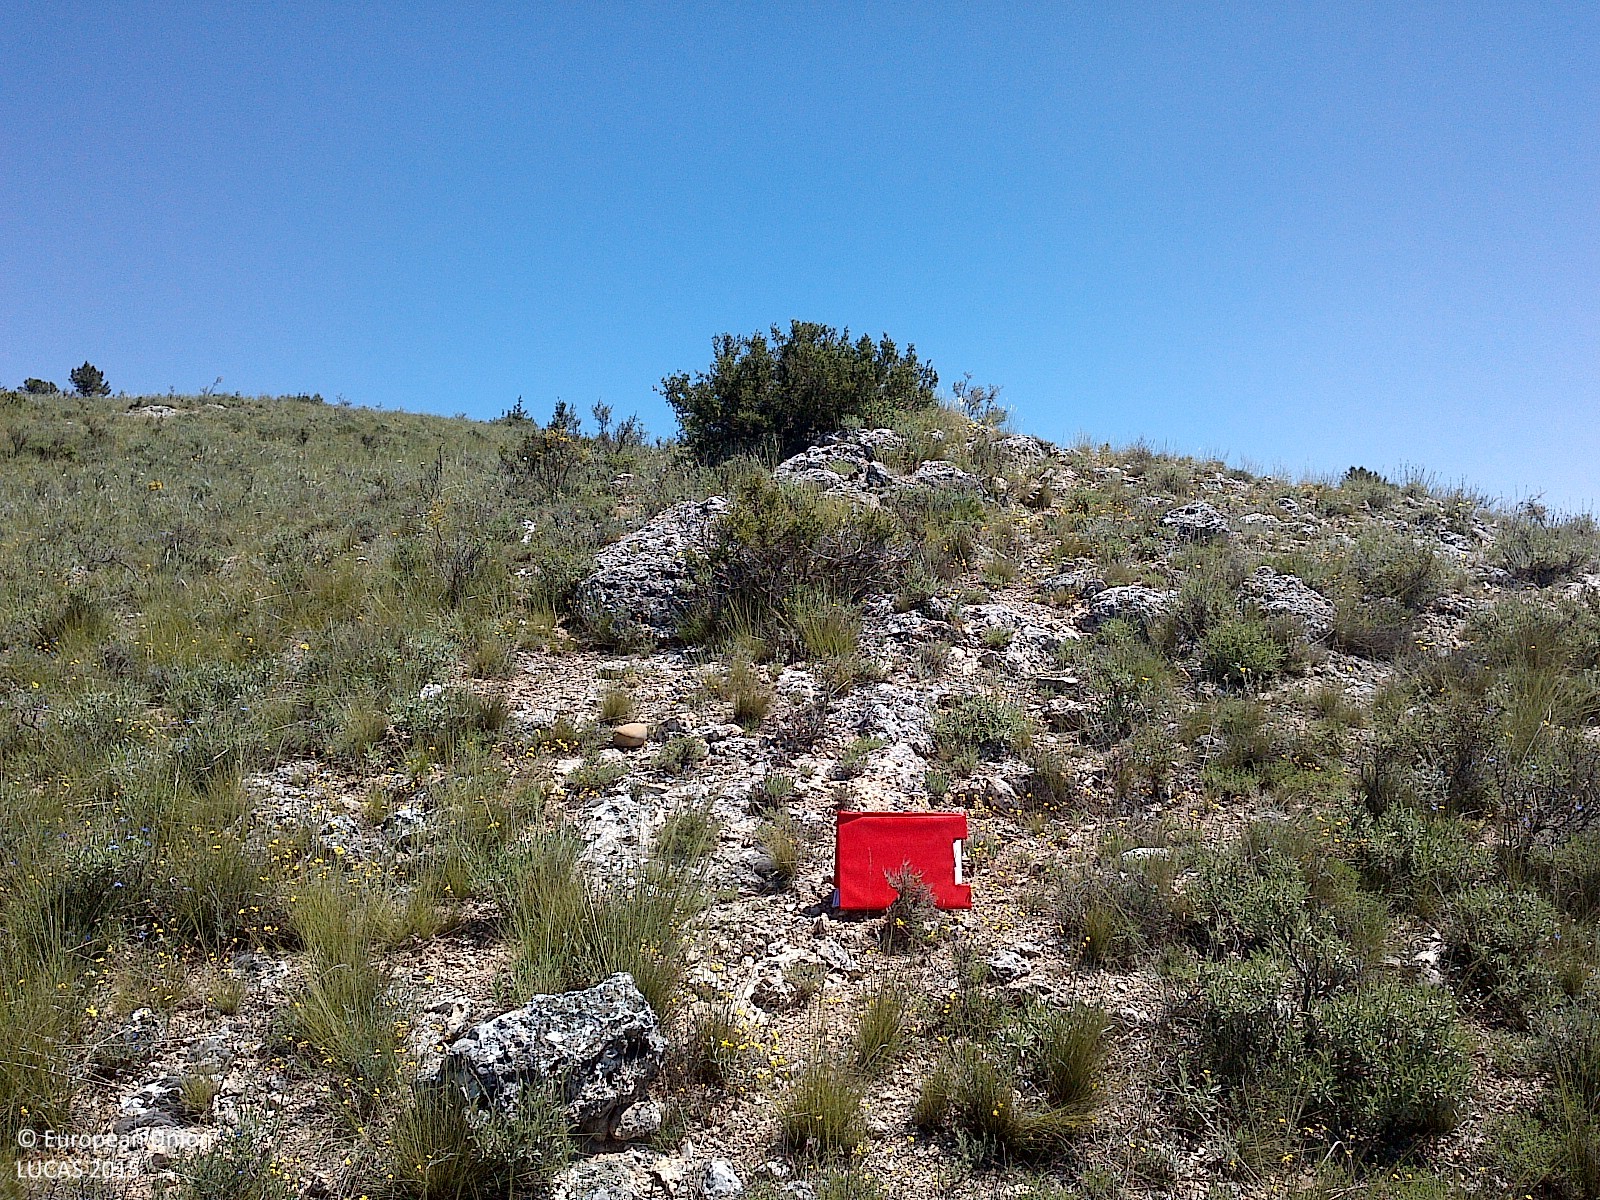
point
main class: Shrubland
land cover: Shrubland without tree cover
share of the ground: 50 - 75 %
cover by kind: shrubs 55 %, consolidated bare surface 35 %, herbaceous plants 10 %
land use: Semi-natural and natural areas not in use
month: May
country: ES
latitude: 41.5676
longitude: -3.0542
